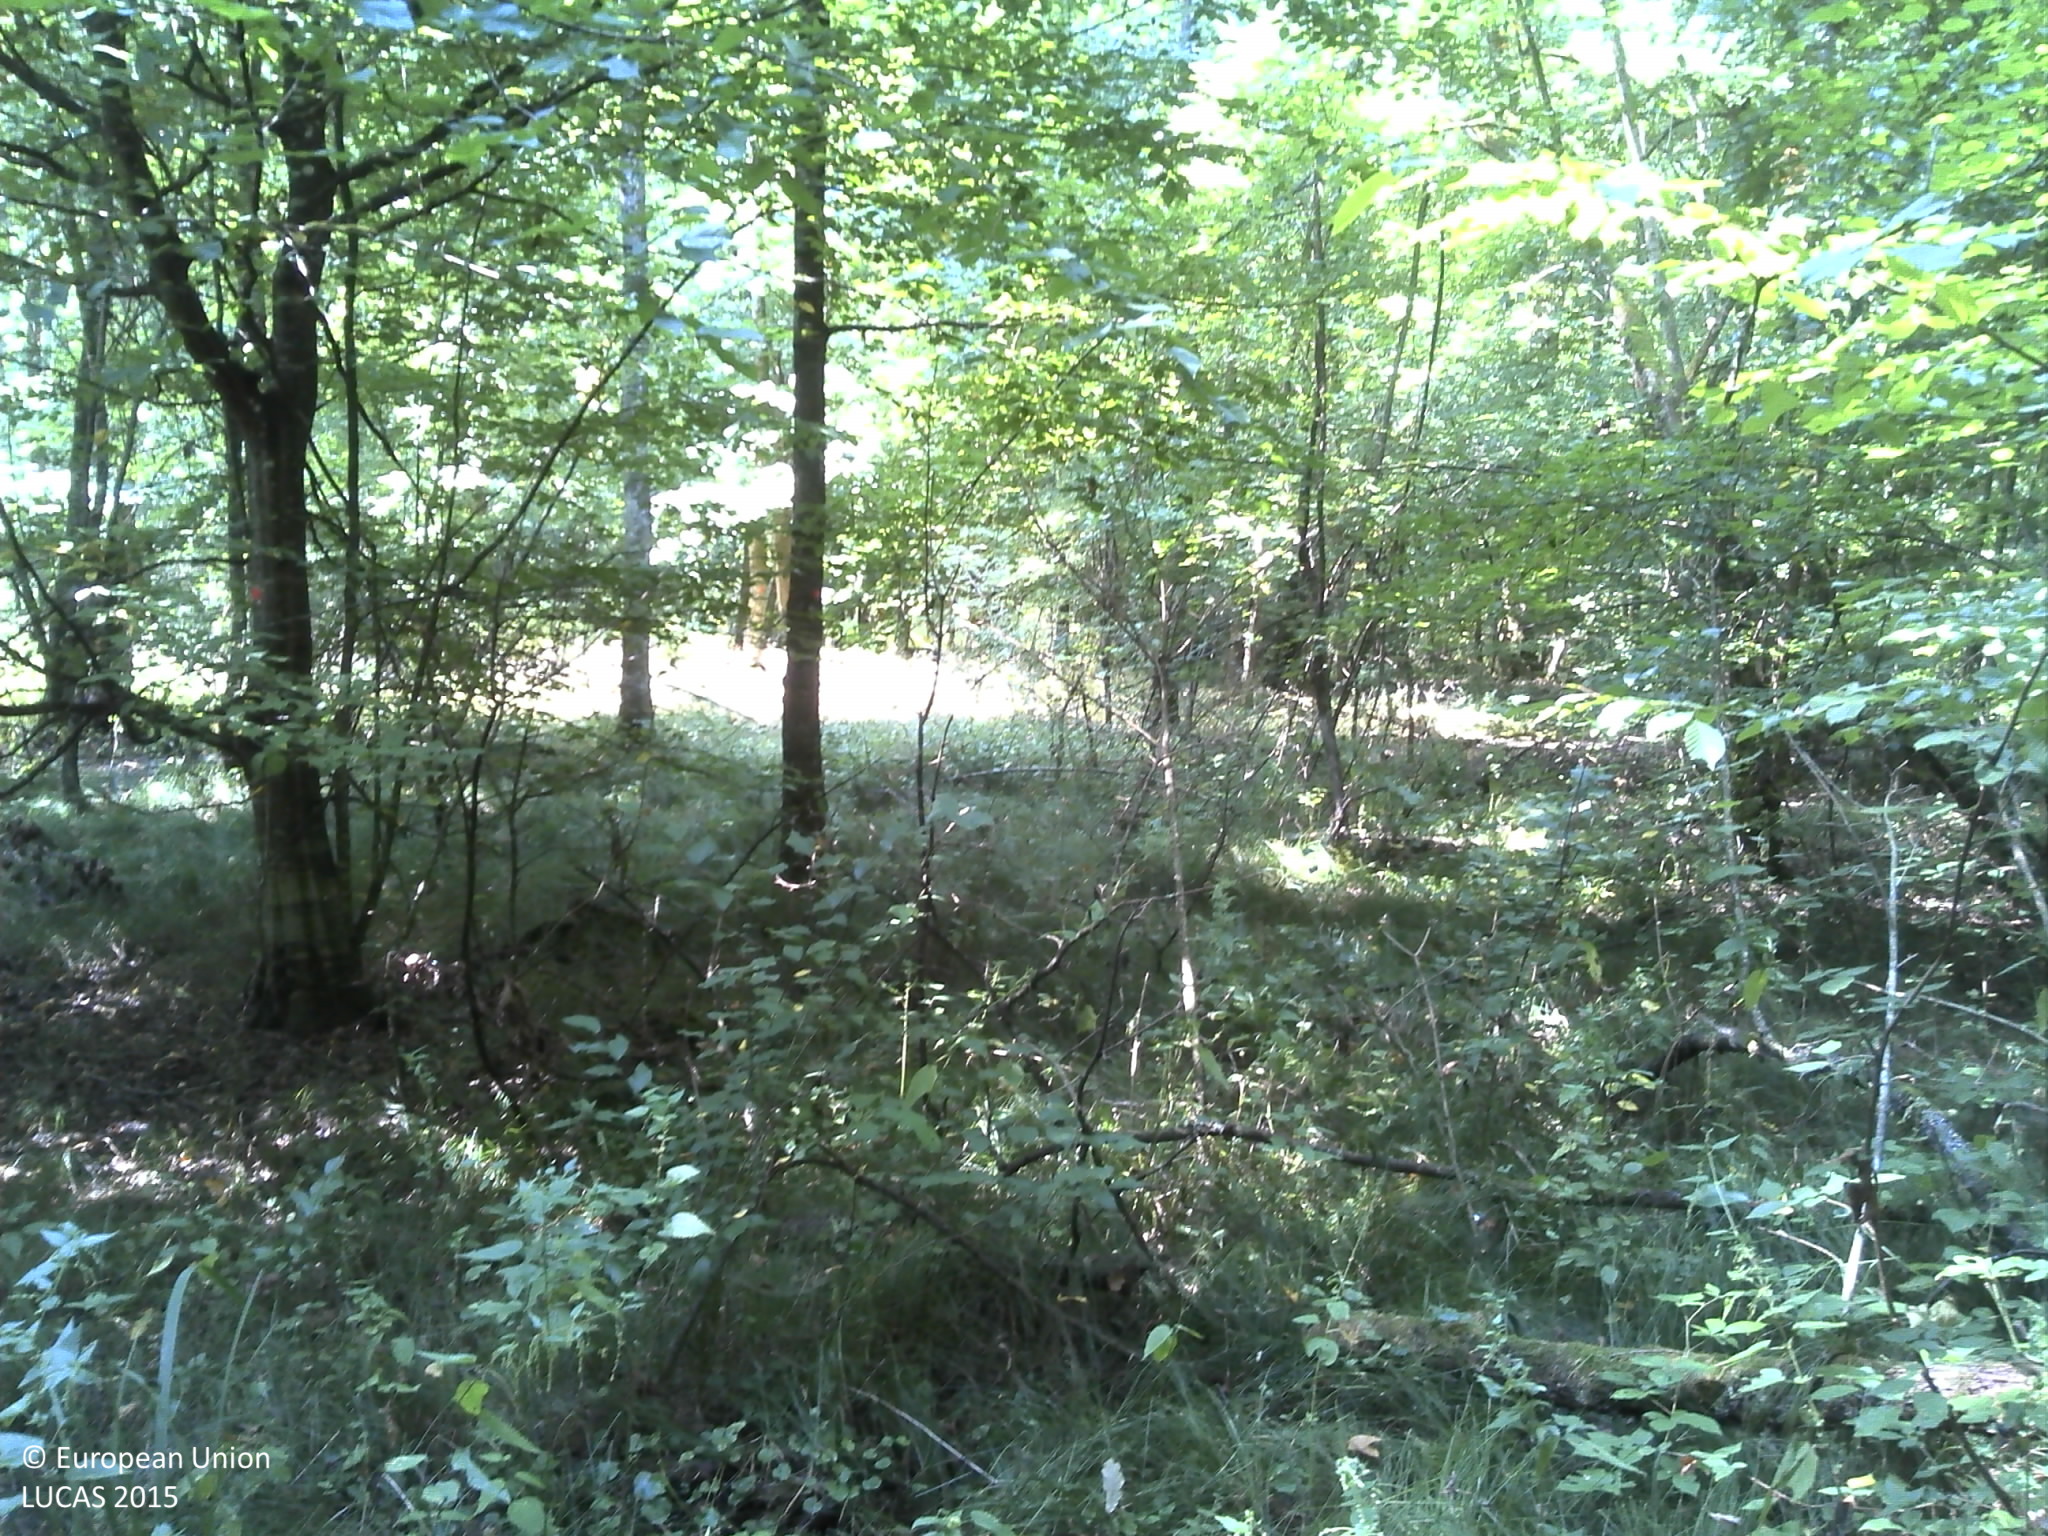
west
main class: Woodland
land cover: Broadleaved woodland
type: mesophytic deciduous forest
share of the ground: > 75 %
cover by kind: broadleaved forest trees 100 %
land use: Forestry
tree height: > 5 m
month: September
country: HR
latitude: 45.6784
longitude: 16.5850
